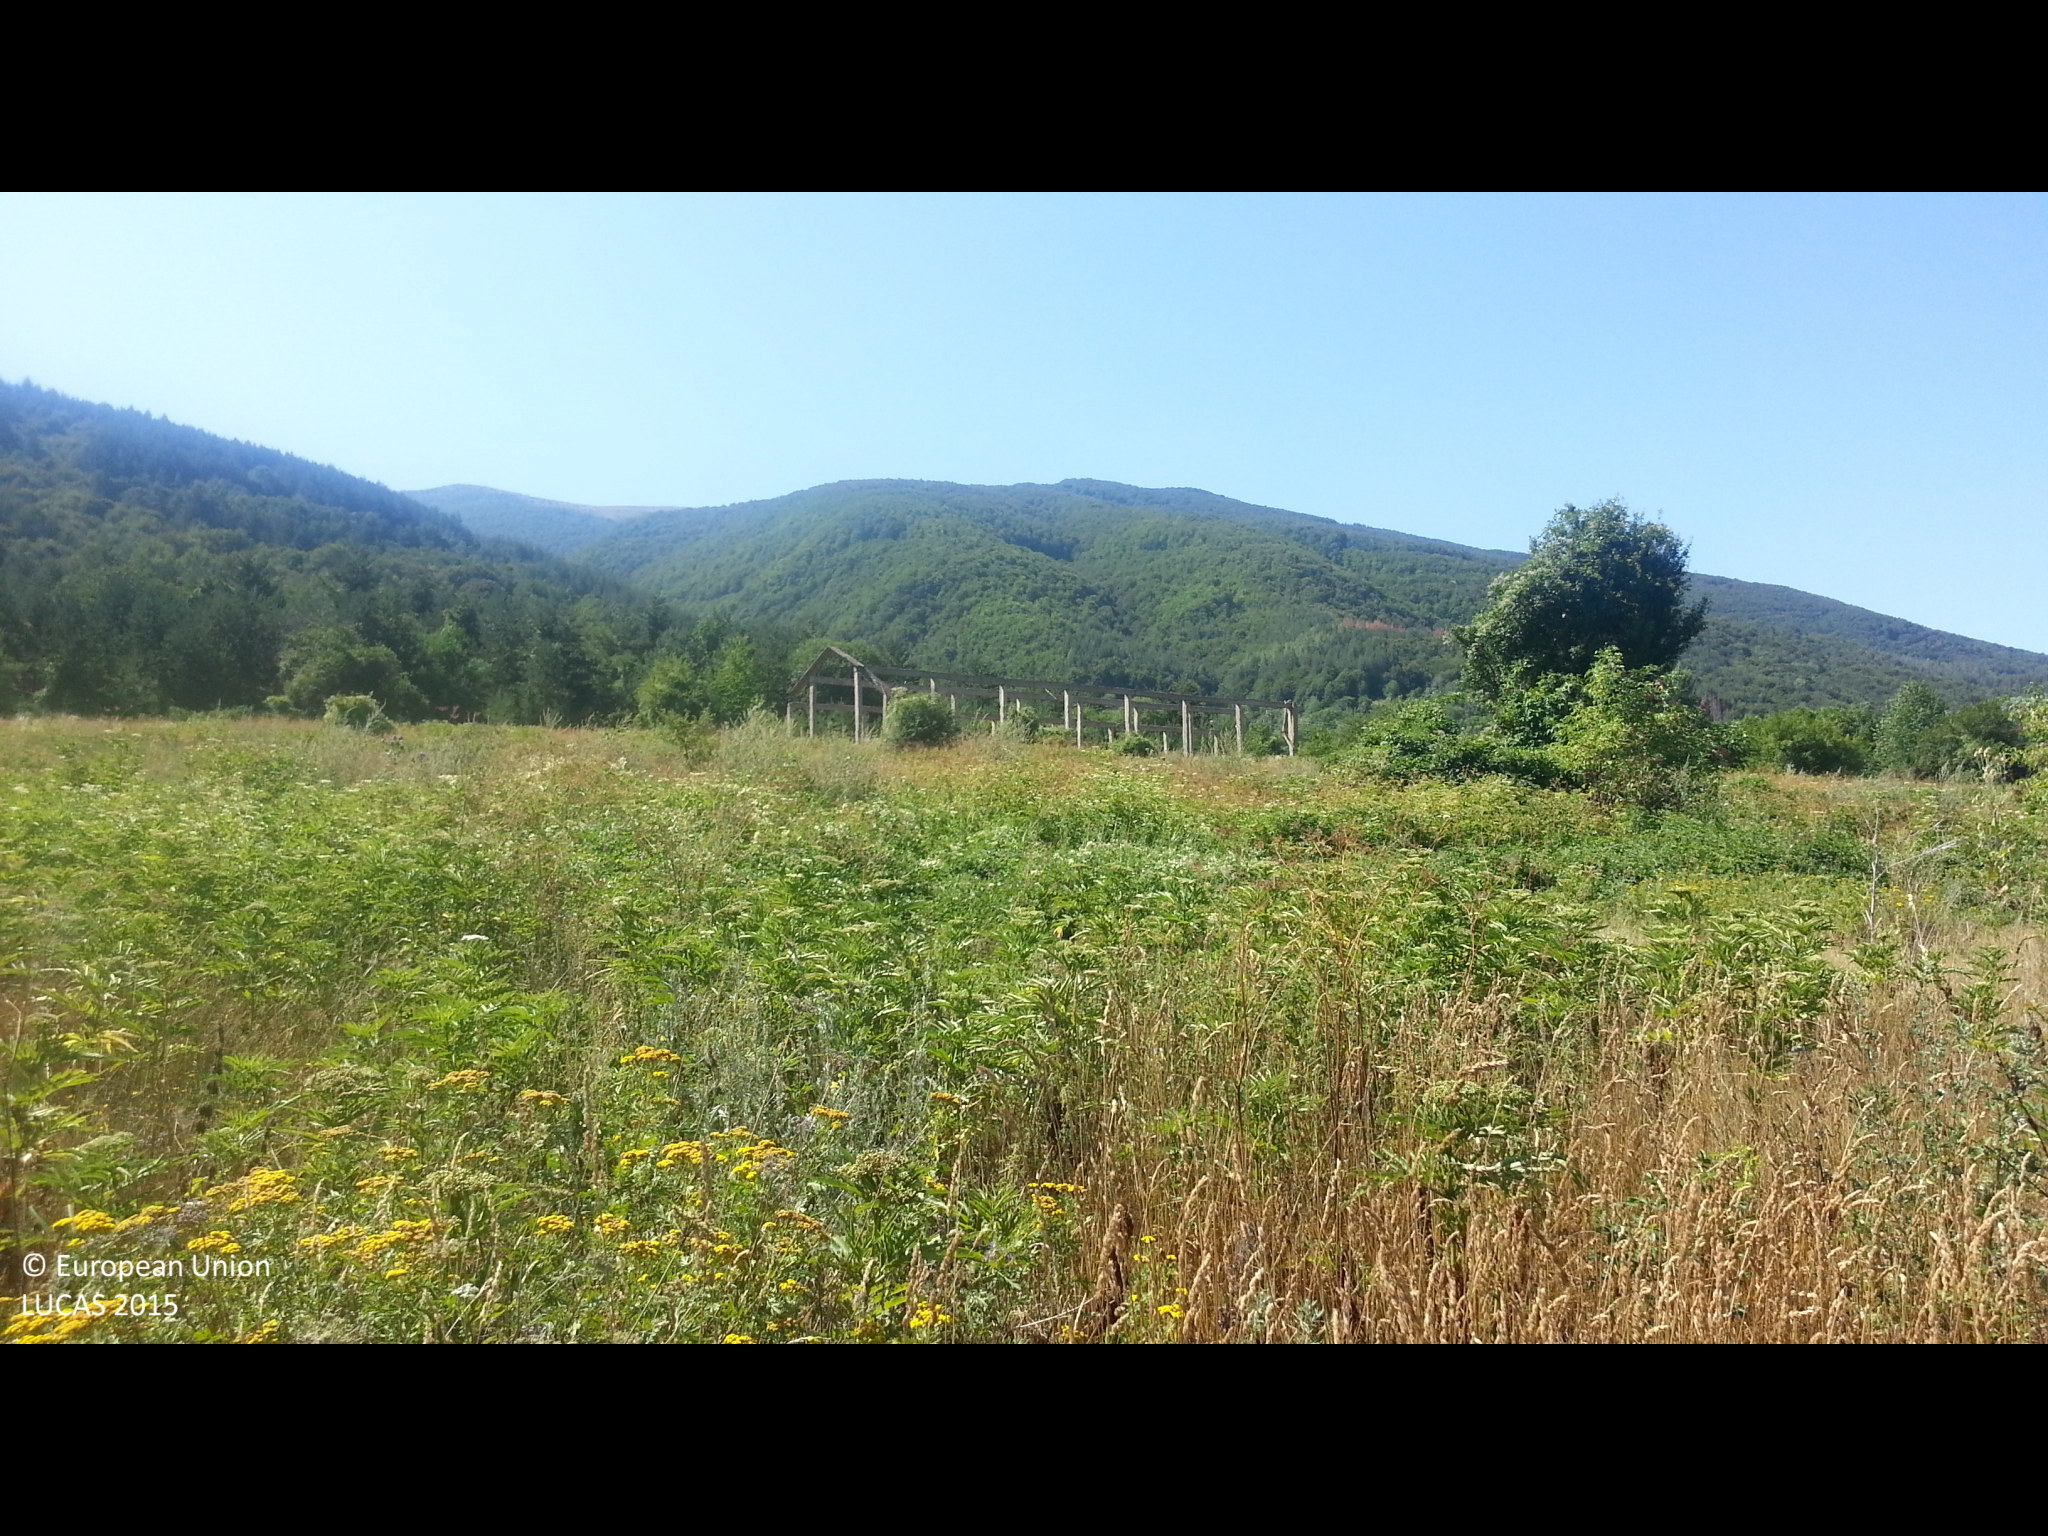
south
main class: Grassland
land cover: Grassland without tree/shrub cover
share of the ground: > 75 %
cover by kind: herbaceous plants 100 %
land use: Semi-natural and natural areas not in use
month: August
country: BG
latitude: 42.2398
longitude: 22.5132
